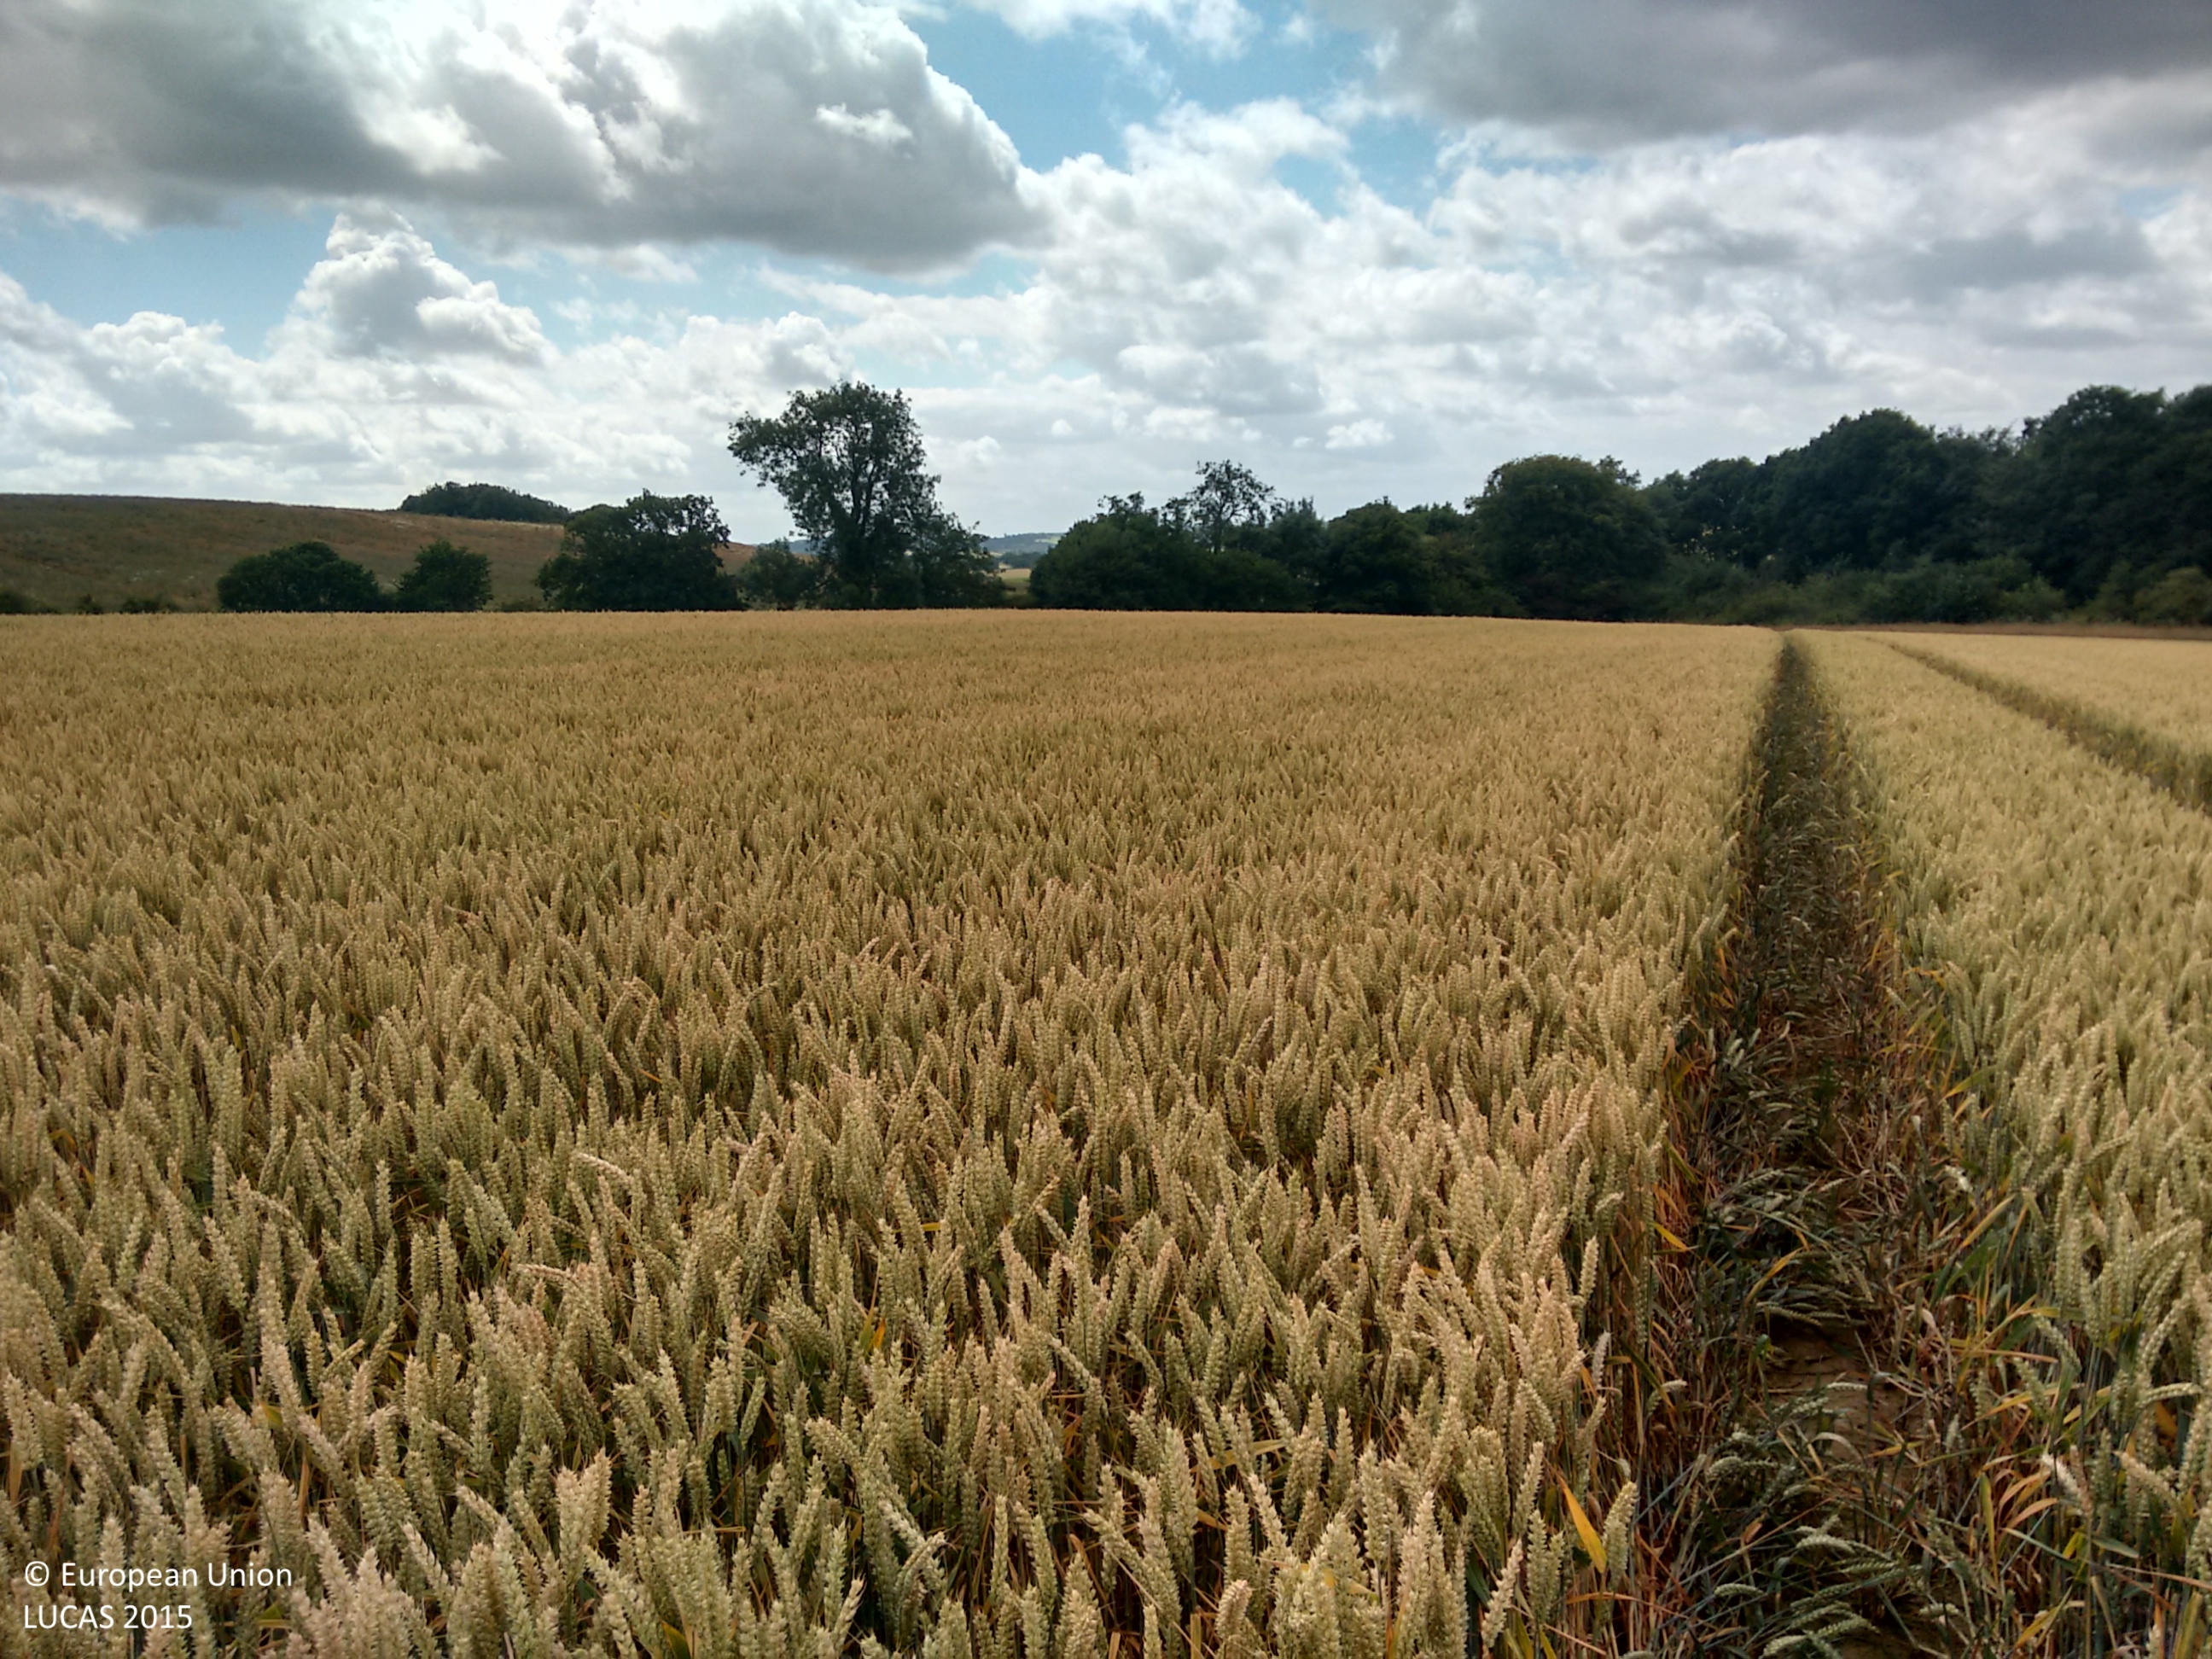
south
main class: Cropland
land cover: Common wheat
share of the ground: > 75 %
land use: Agriculture (excluding fallow land and kitchen gardens)
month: July
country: GB
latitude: 53.1351
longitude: -1.0001
